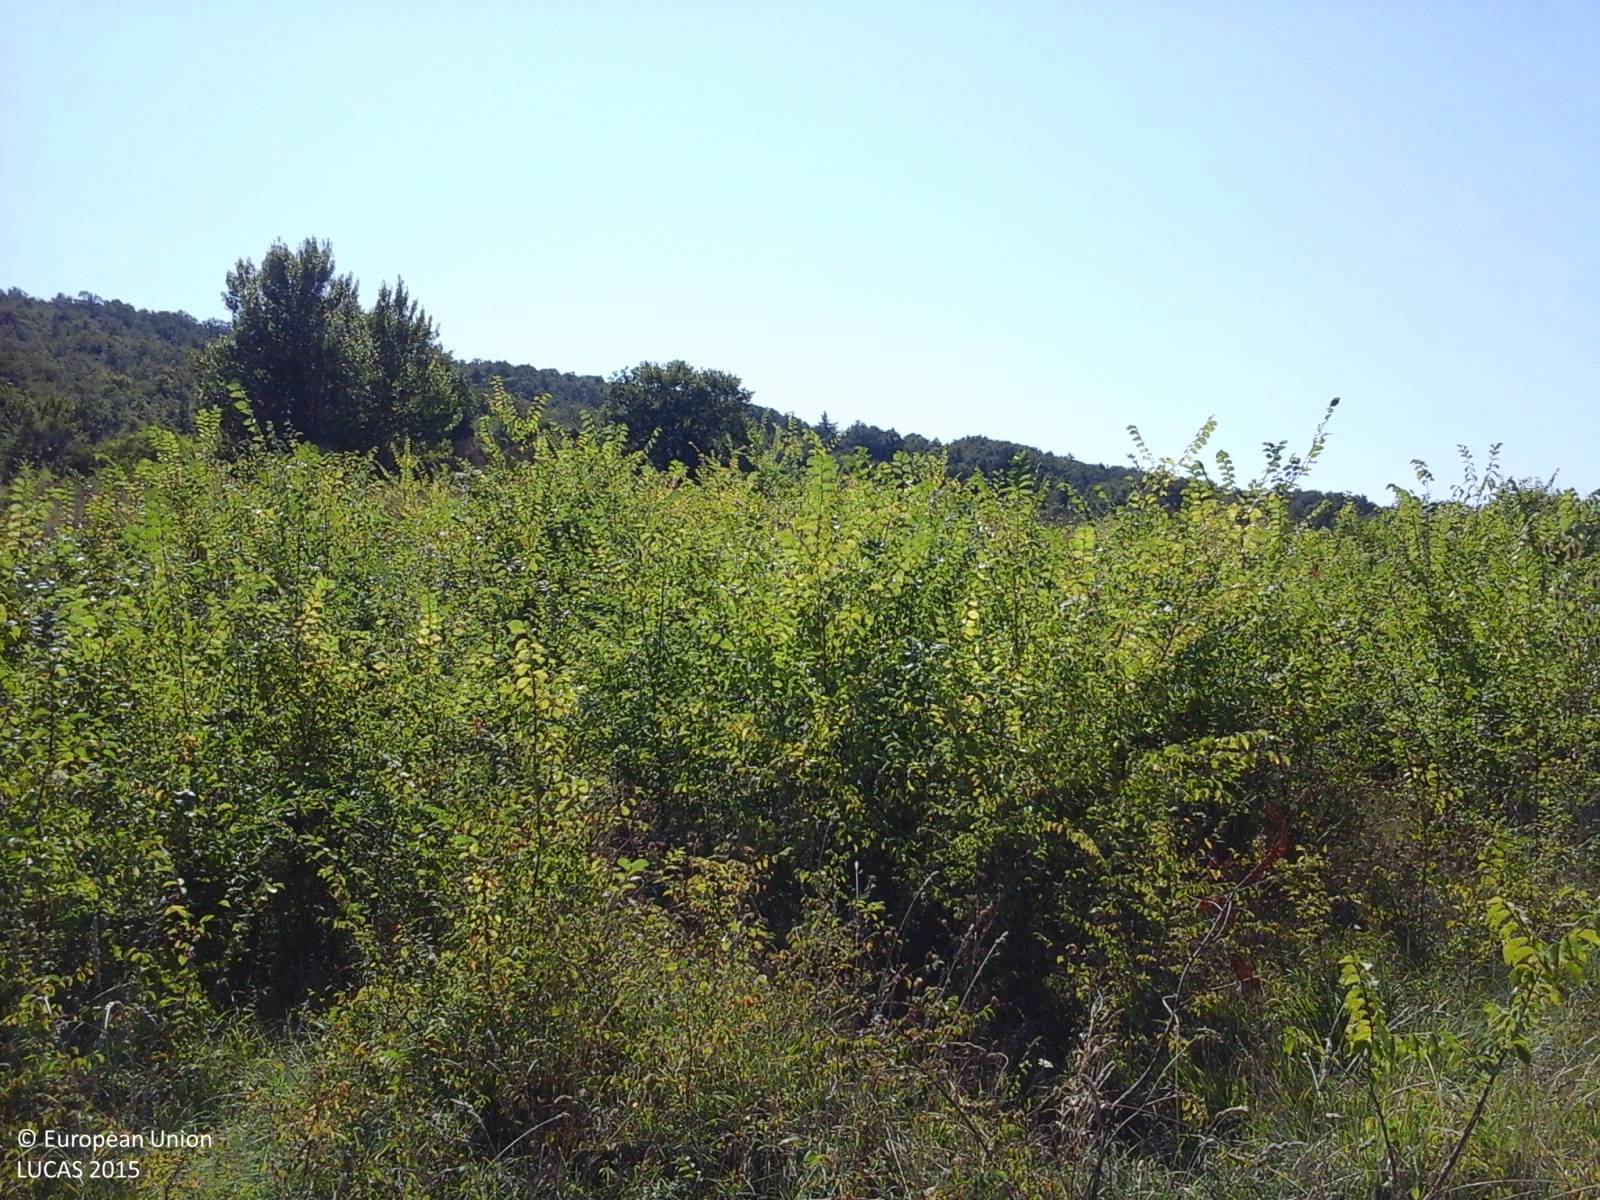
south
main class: Shrubland
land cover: Shrubland with sparse tree cover
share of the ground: 50 - 75 %
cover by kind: shrubs 55 %, herbaceous plants 40 %, broadleaved forest trees 5 %
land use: Abandoned areas
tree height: < 5 m
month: September
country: IT
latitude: 43.1256
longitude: 12.6352
